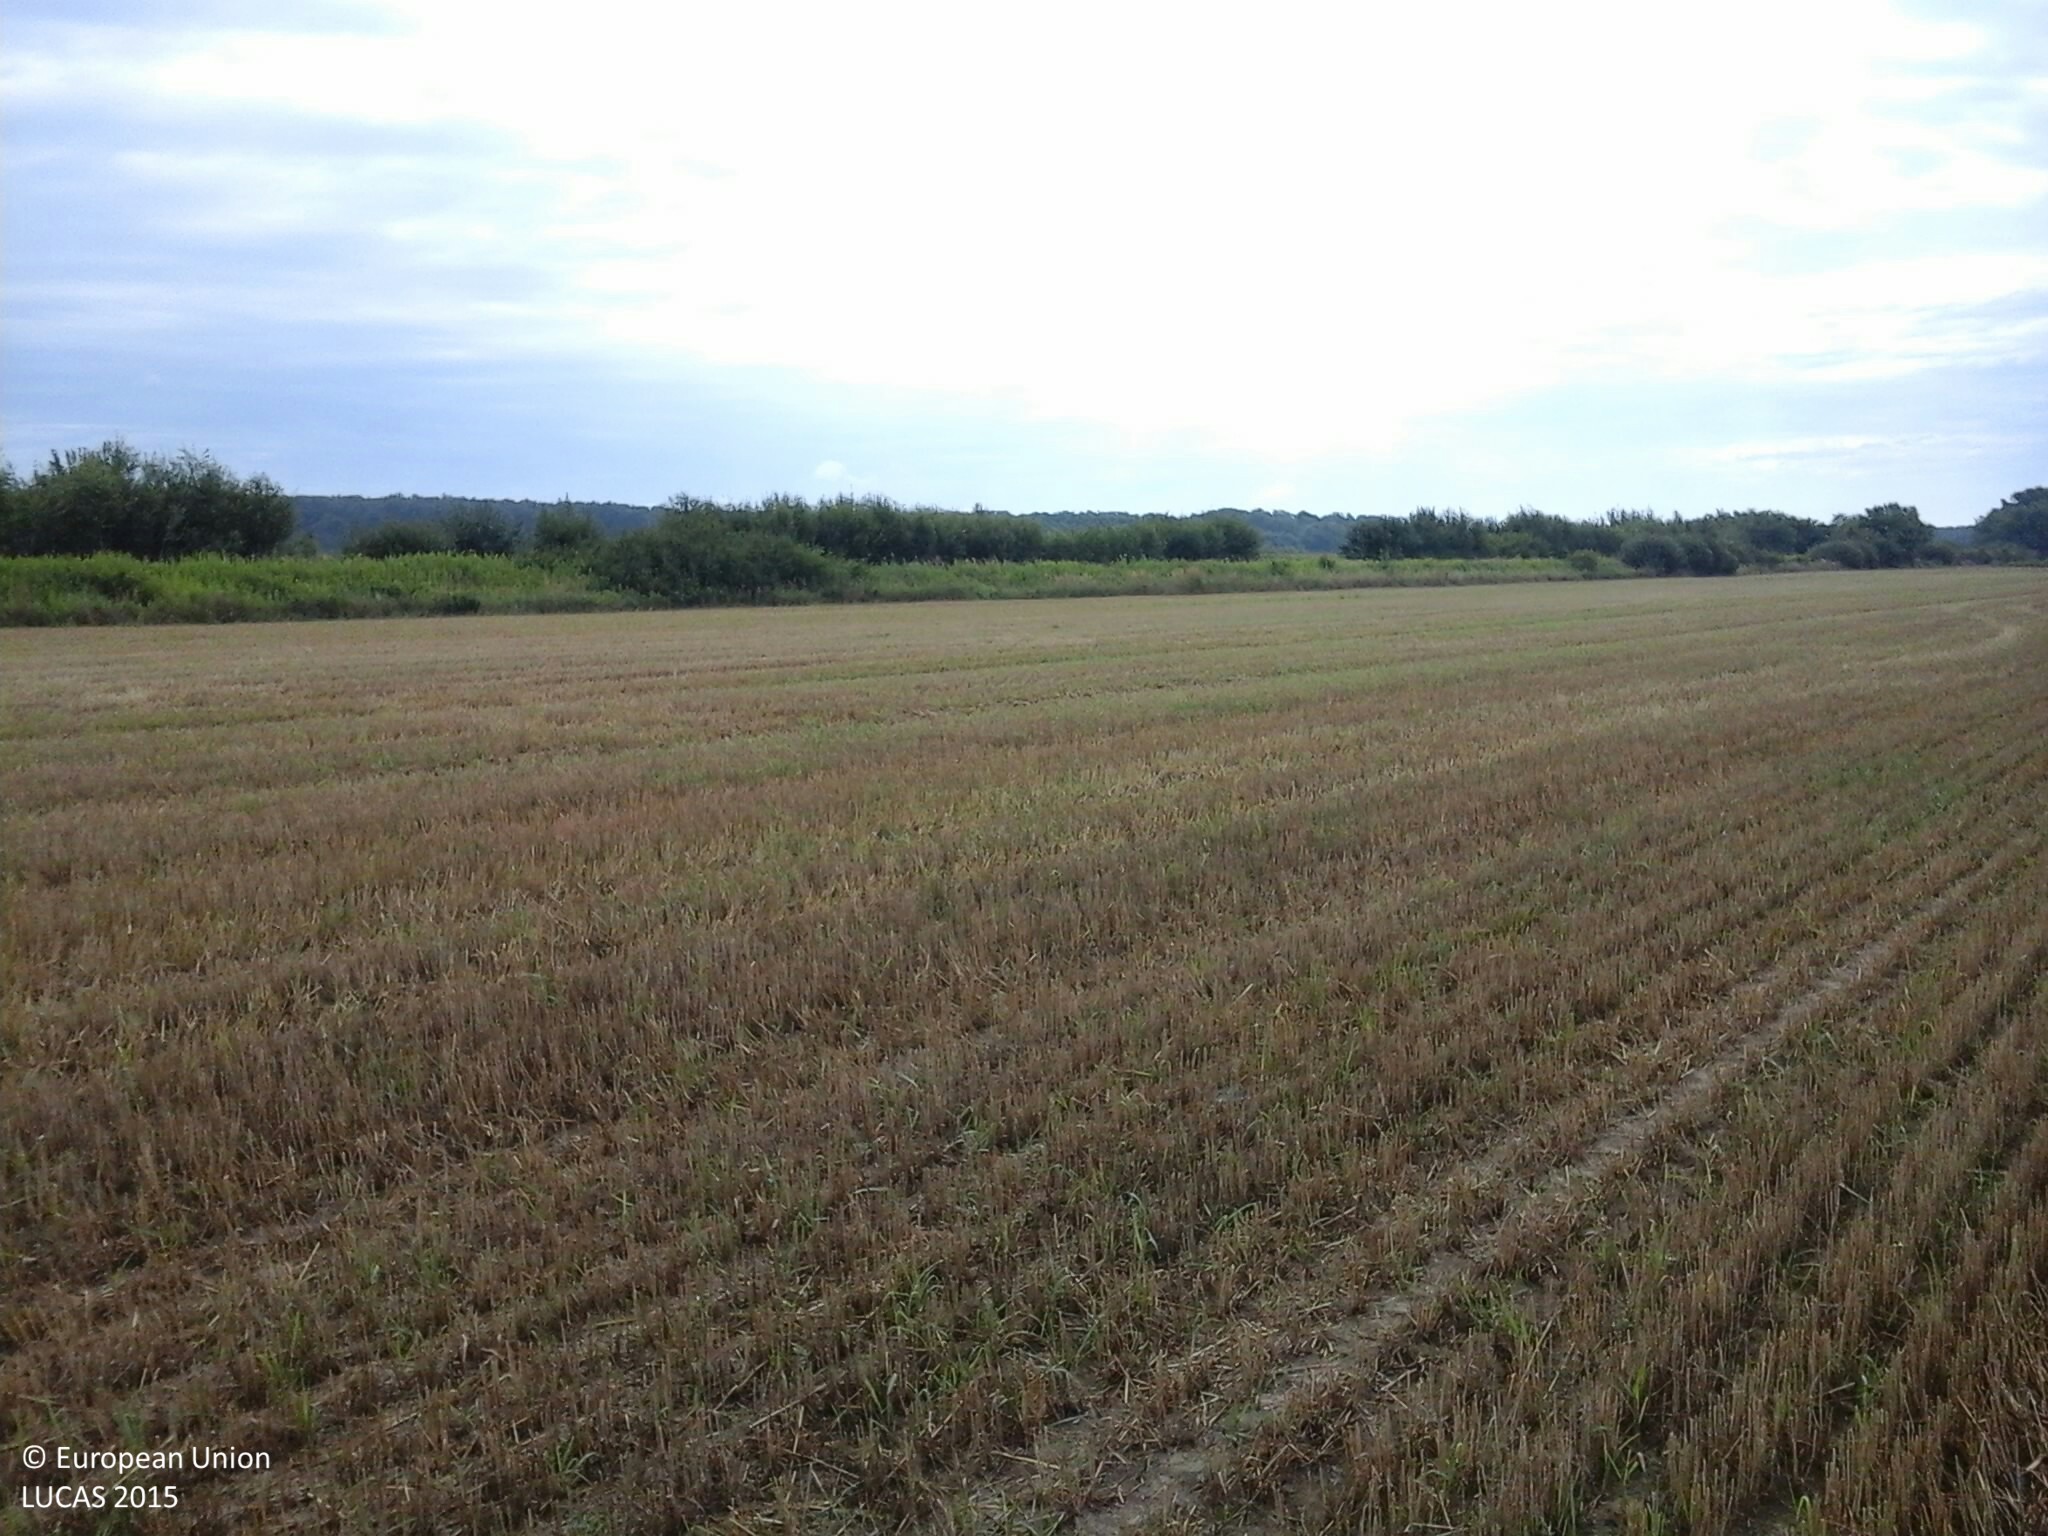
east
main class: Cropland
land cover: Common wheat
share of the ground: 10 - 25 %
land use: Agriculture (excluding fallow land and kitchen gardens)
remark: Harvested field
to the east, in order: Common wheat; Ditches and canals; Grass margins; Tracks; Grass margins; Ditches and canals; Managed hedges; Common wheat; Maize
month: July
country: HU
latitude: 46.6969
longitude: 16.4750
